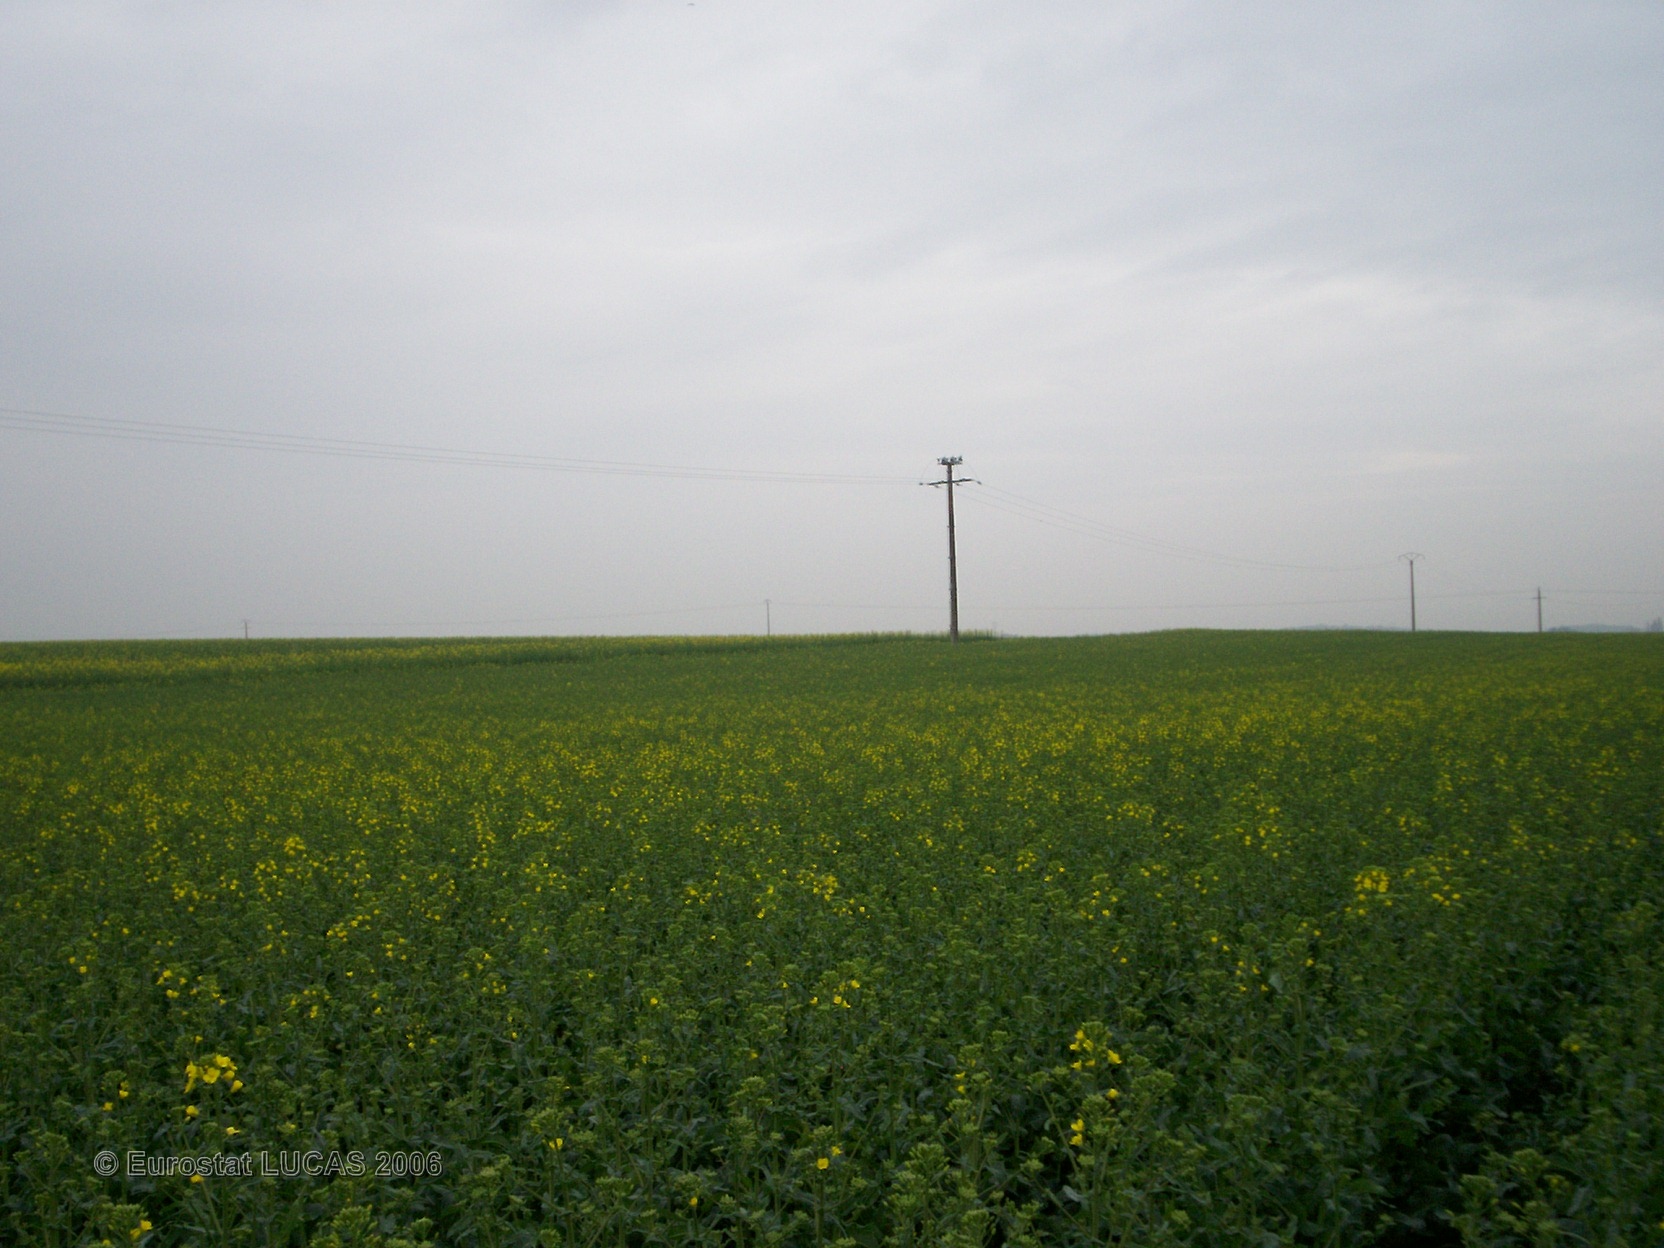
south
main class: Cropland
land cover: Rape and turnip rape
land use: Agriculture (excluding fallow land and kitchen gardens)
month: April
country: FR
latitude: 48.2222
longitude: 2.7901
